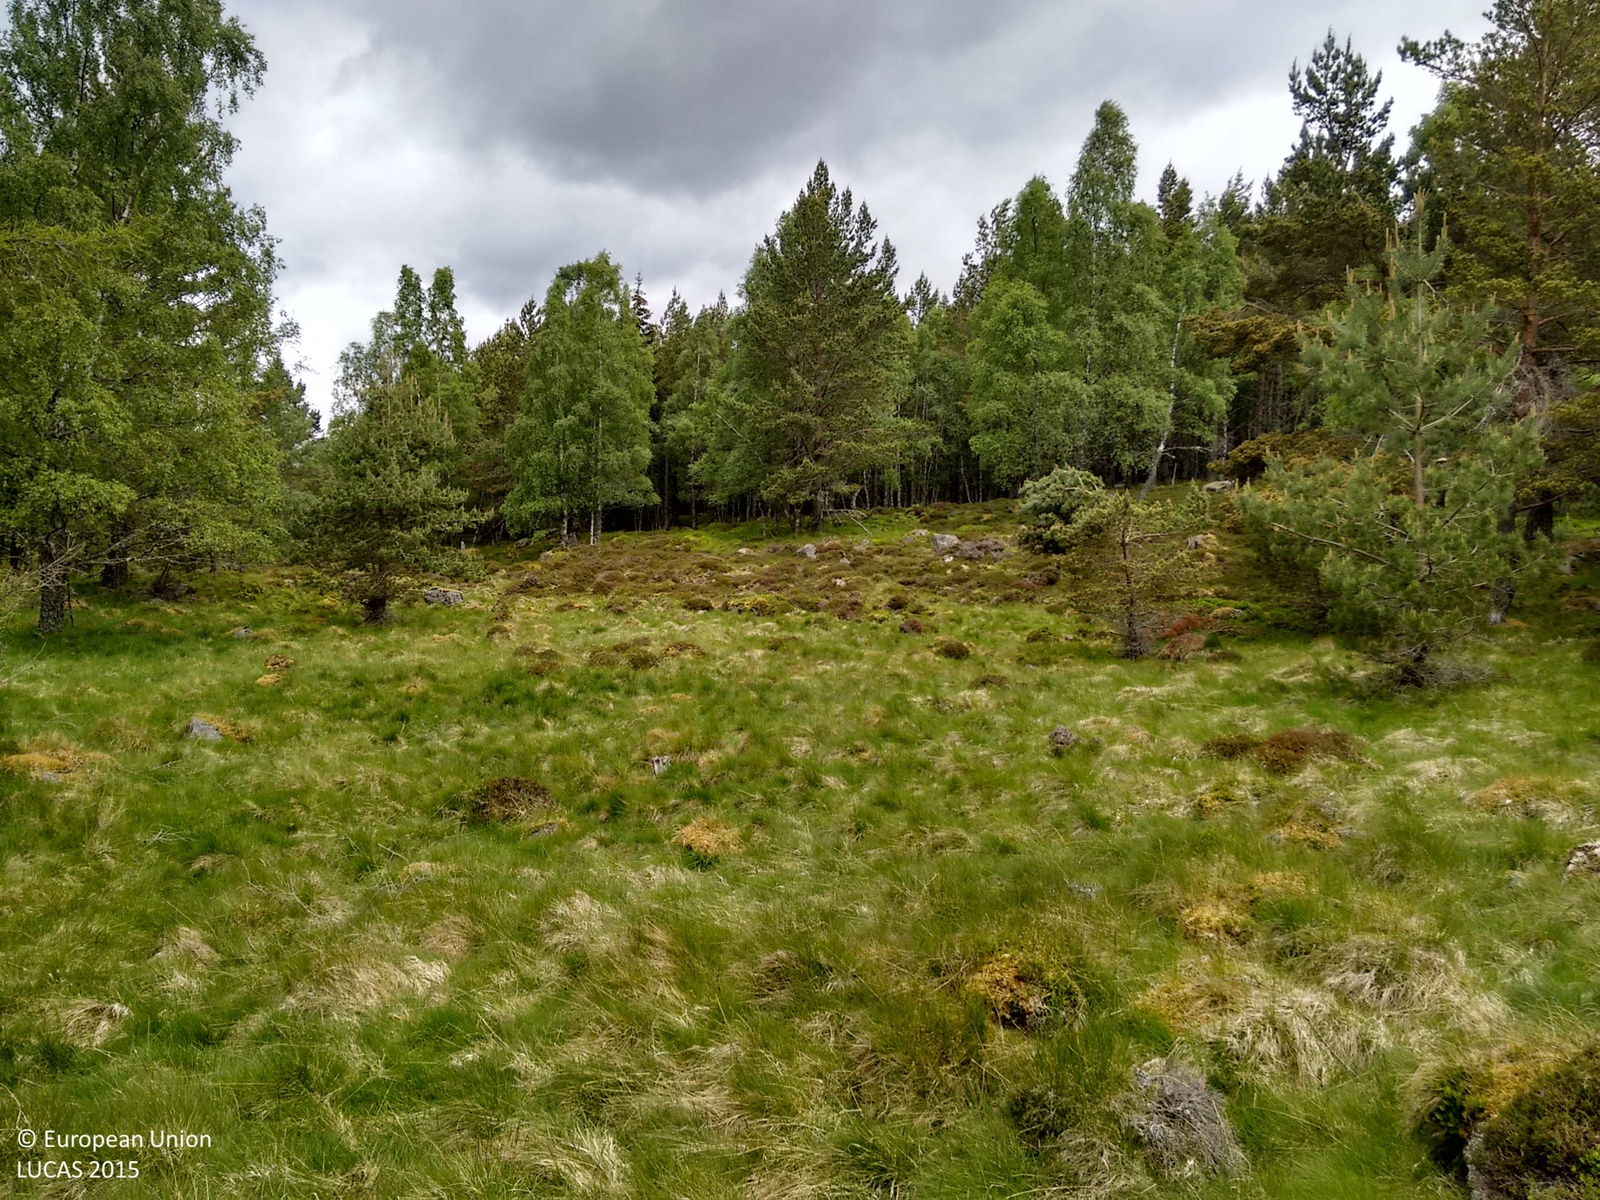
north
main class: Woodland
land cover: Pine dominated coniferous woodland
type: exotic forest
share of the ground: > 75 %
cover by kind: herbaceous plants 60 %, coniferous forest trees 30 %, shrubs 10 %
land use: Semi-natural and natural areas not in use
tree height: > 5 m
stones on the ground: < 10 %
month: June
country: GB
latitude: 57.0317
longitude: -3.2325
